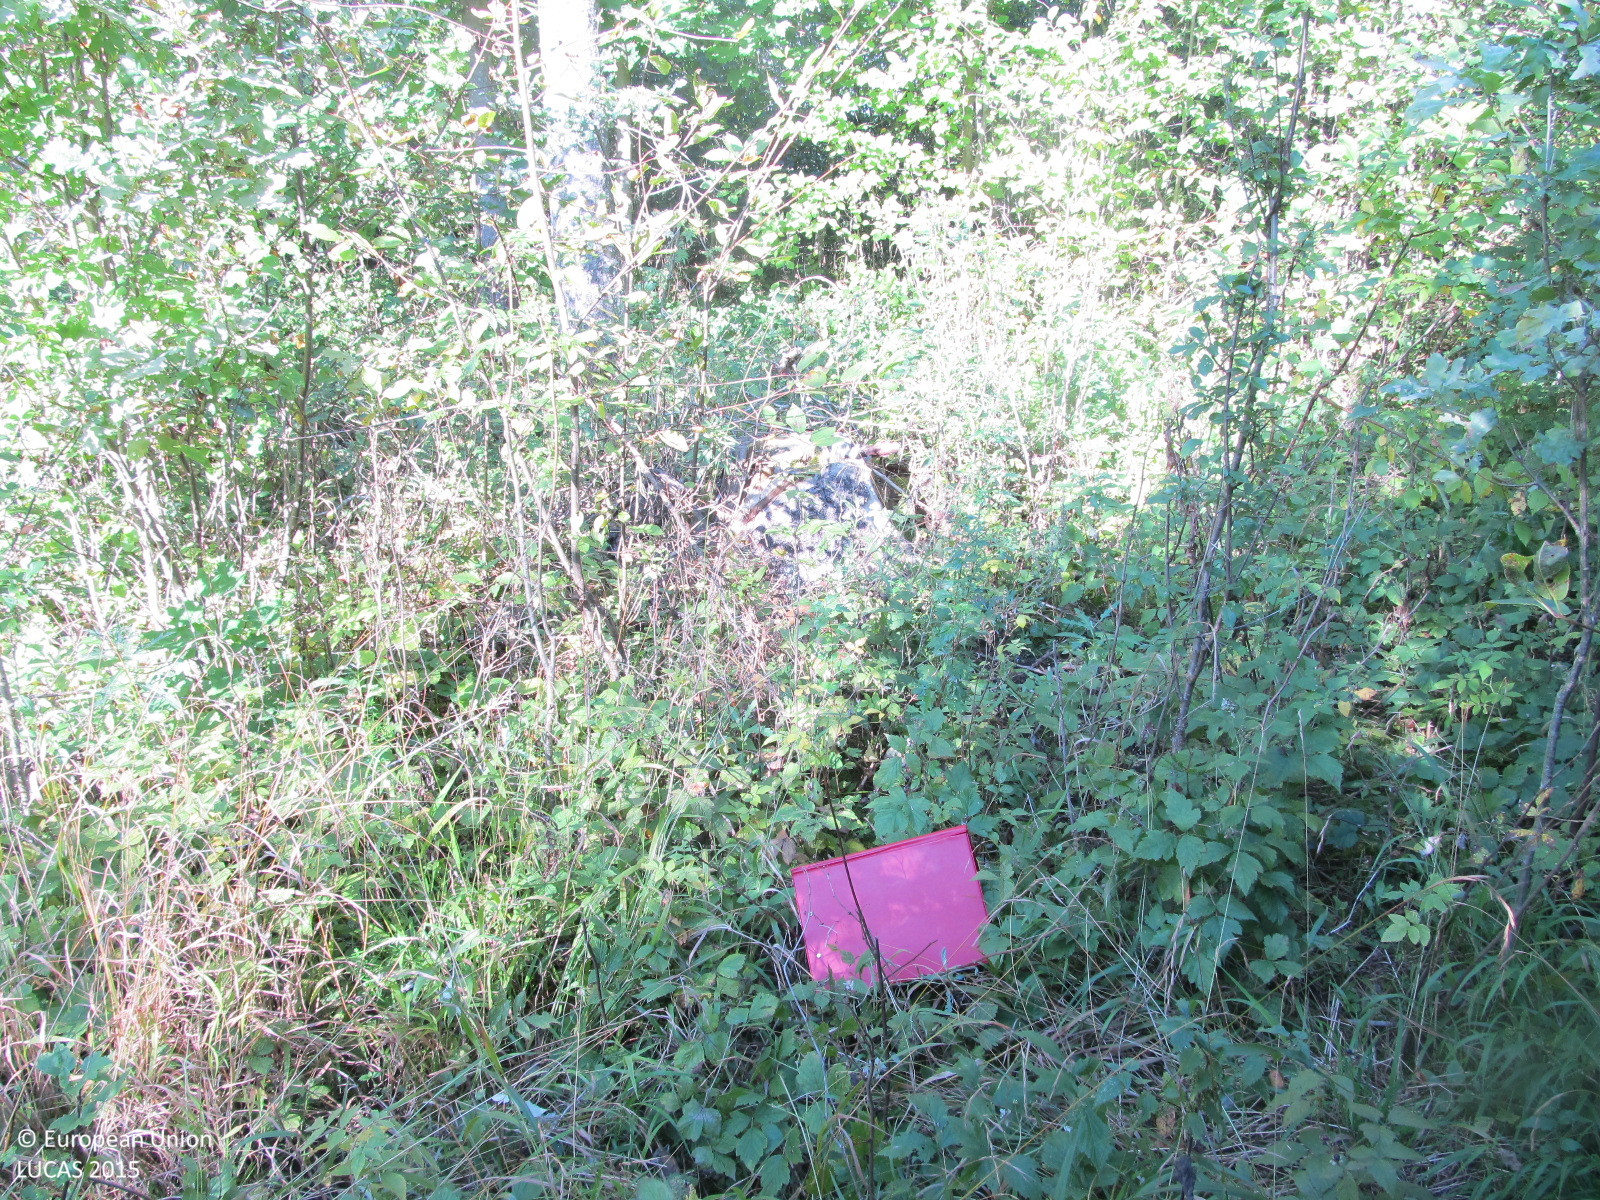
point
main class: Woodland
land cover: Spruce dominated mixed woodland
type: hemiboreal forest and nemoral coniferous forest and mixed broadleaved-coniferous forest
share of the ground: 50 - 75 %
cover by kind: coniferous forest trees 30 %, broadleaved forest trees 30 %, shrubs 20 %, herbaceous plants 20 %
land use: Forestry
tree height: > 5 m
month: September
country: LT
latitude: 56.2417
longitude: 22.9257
